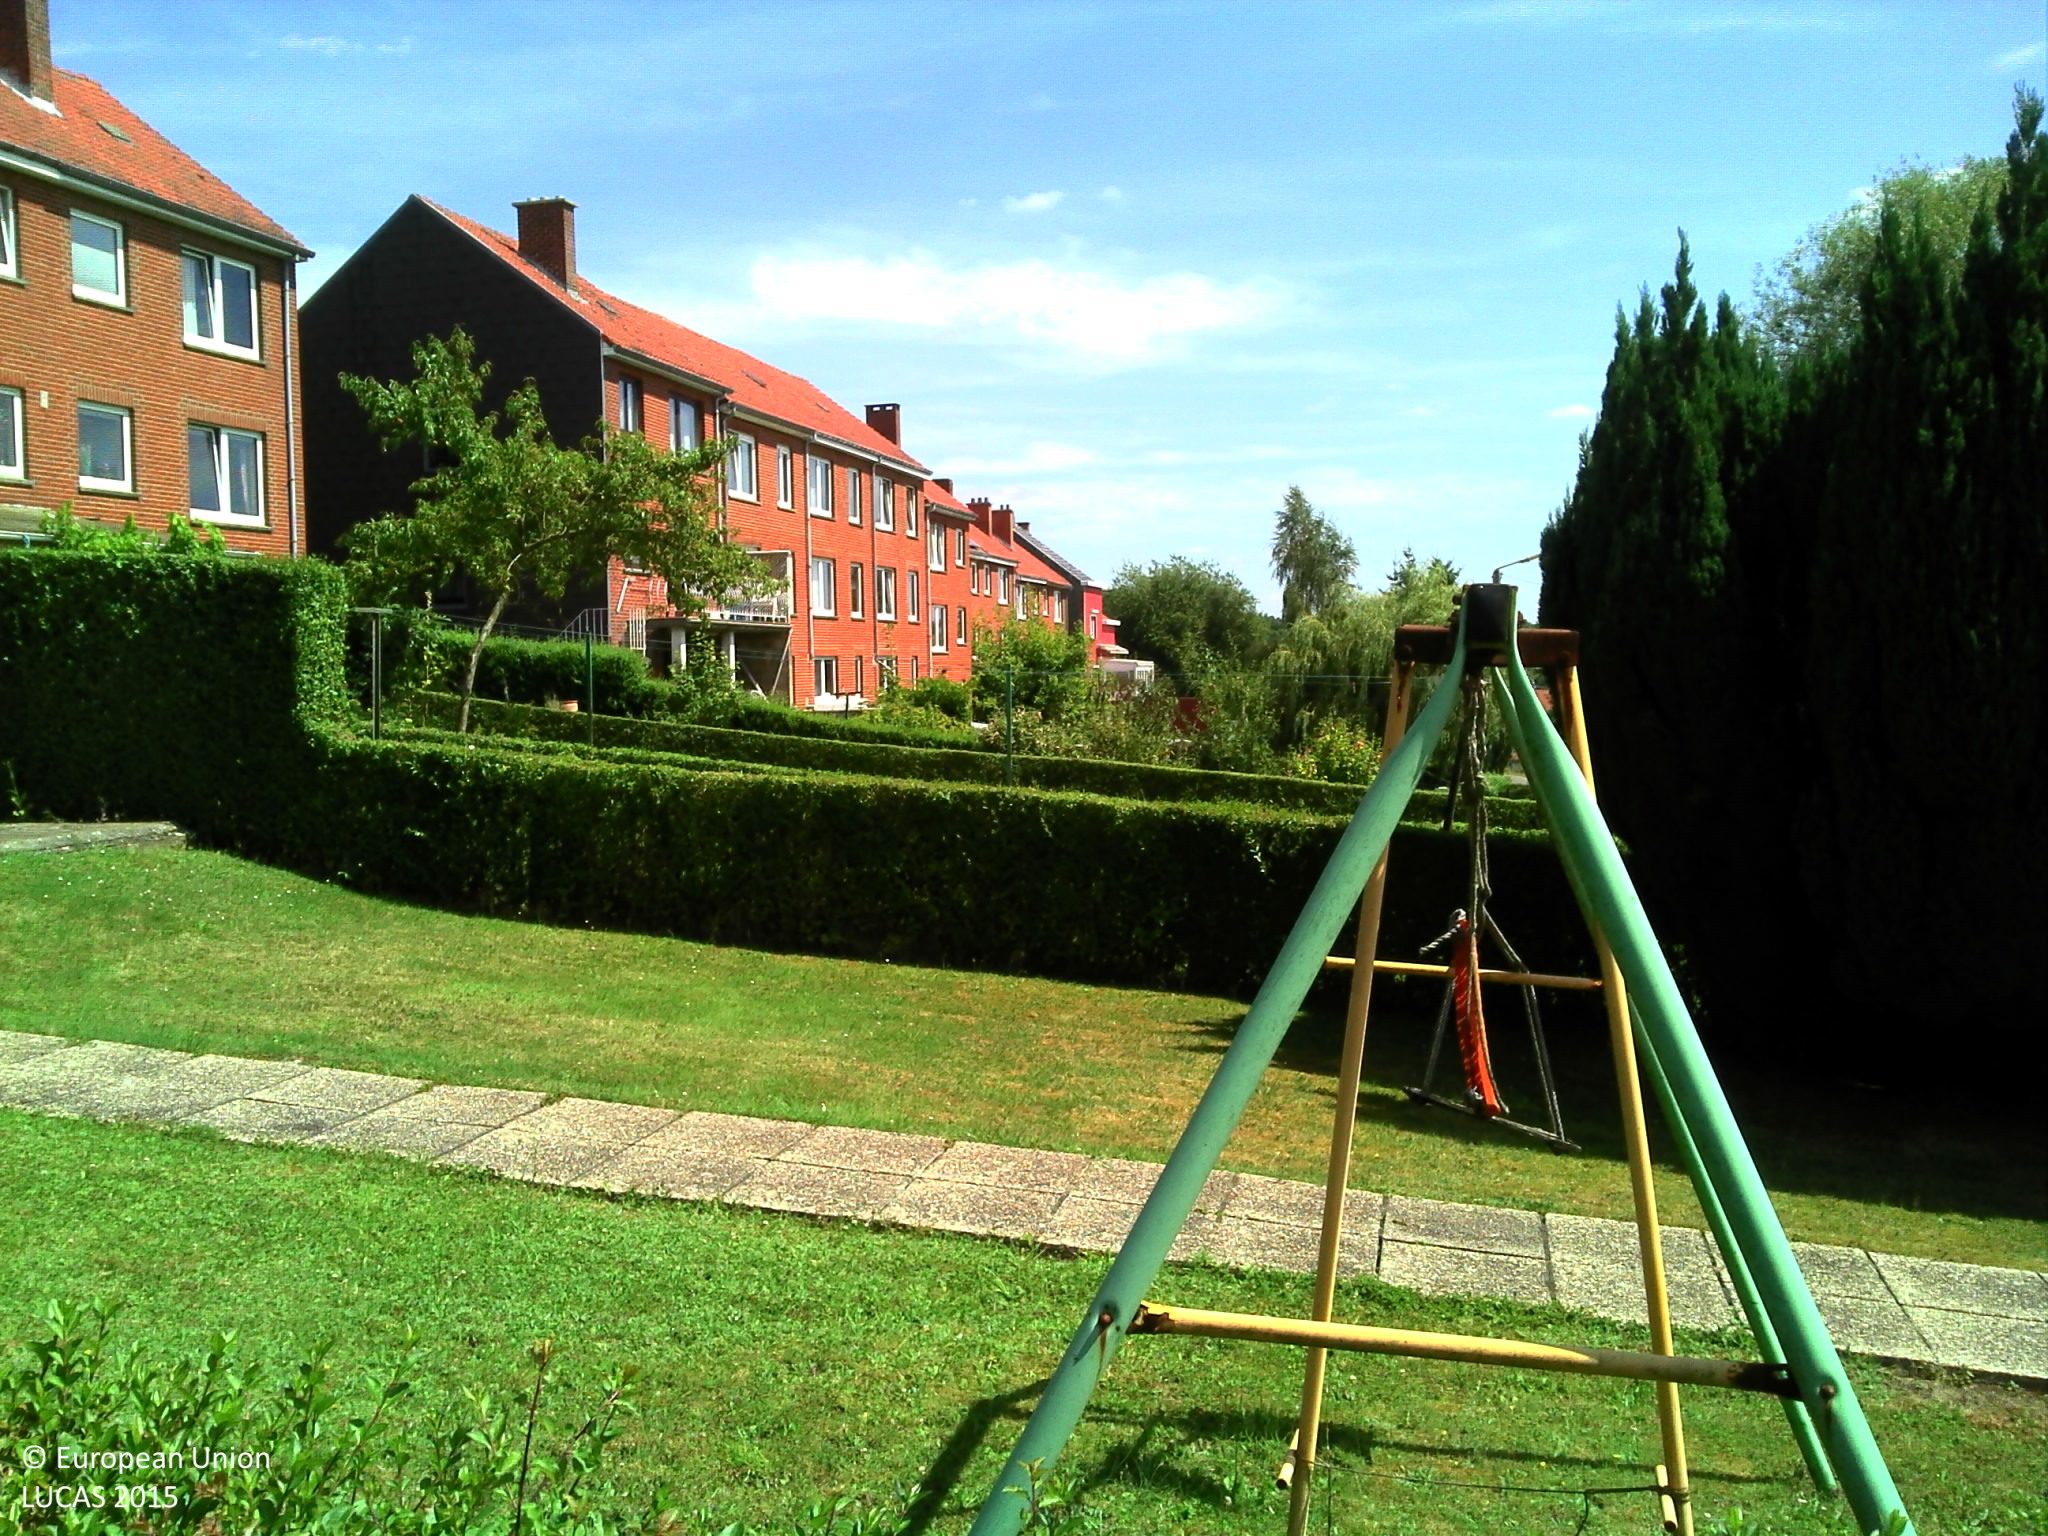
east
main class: Grassland
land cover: Grassland without tree/shrub cover
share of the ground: > 75 %
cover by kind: herbaceous plants 100 %
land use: Residential
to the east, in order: Tracks; Managed hedges; Grassland without tree/shrub cover; Artificial constructions in urban areas
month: August
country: BE
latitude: 50.3593
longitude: 4.5280
